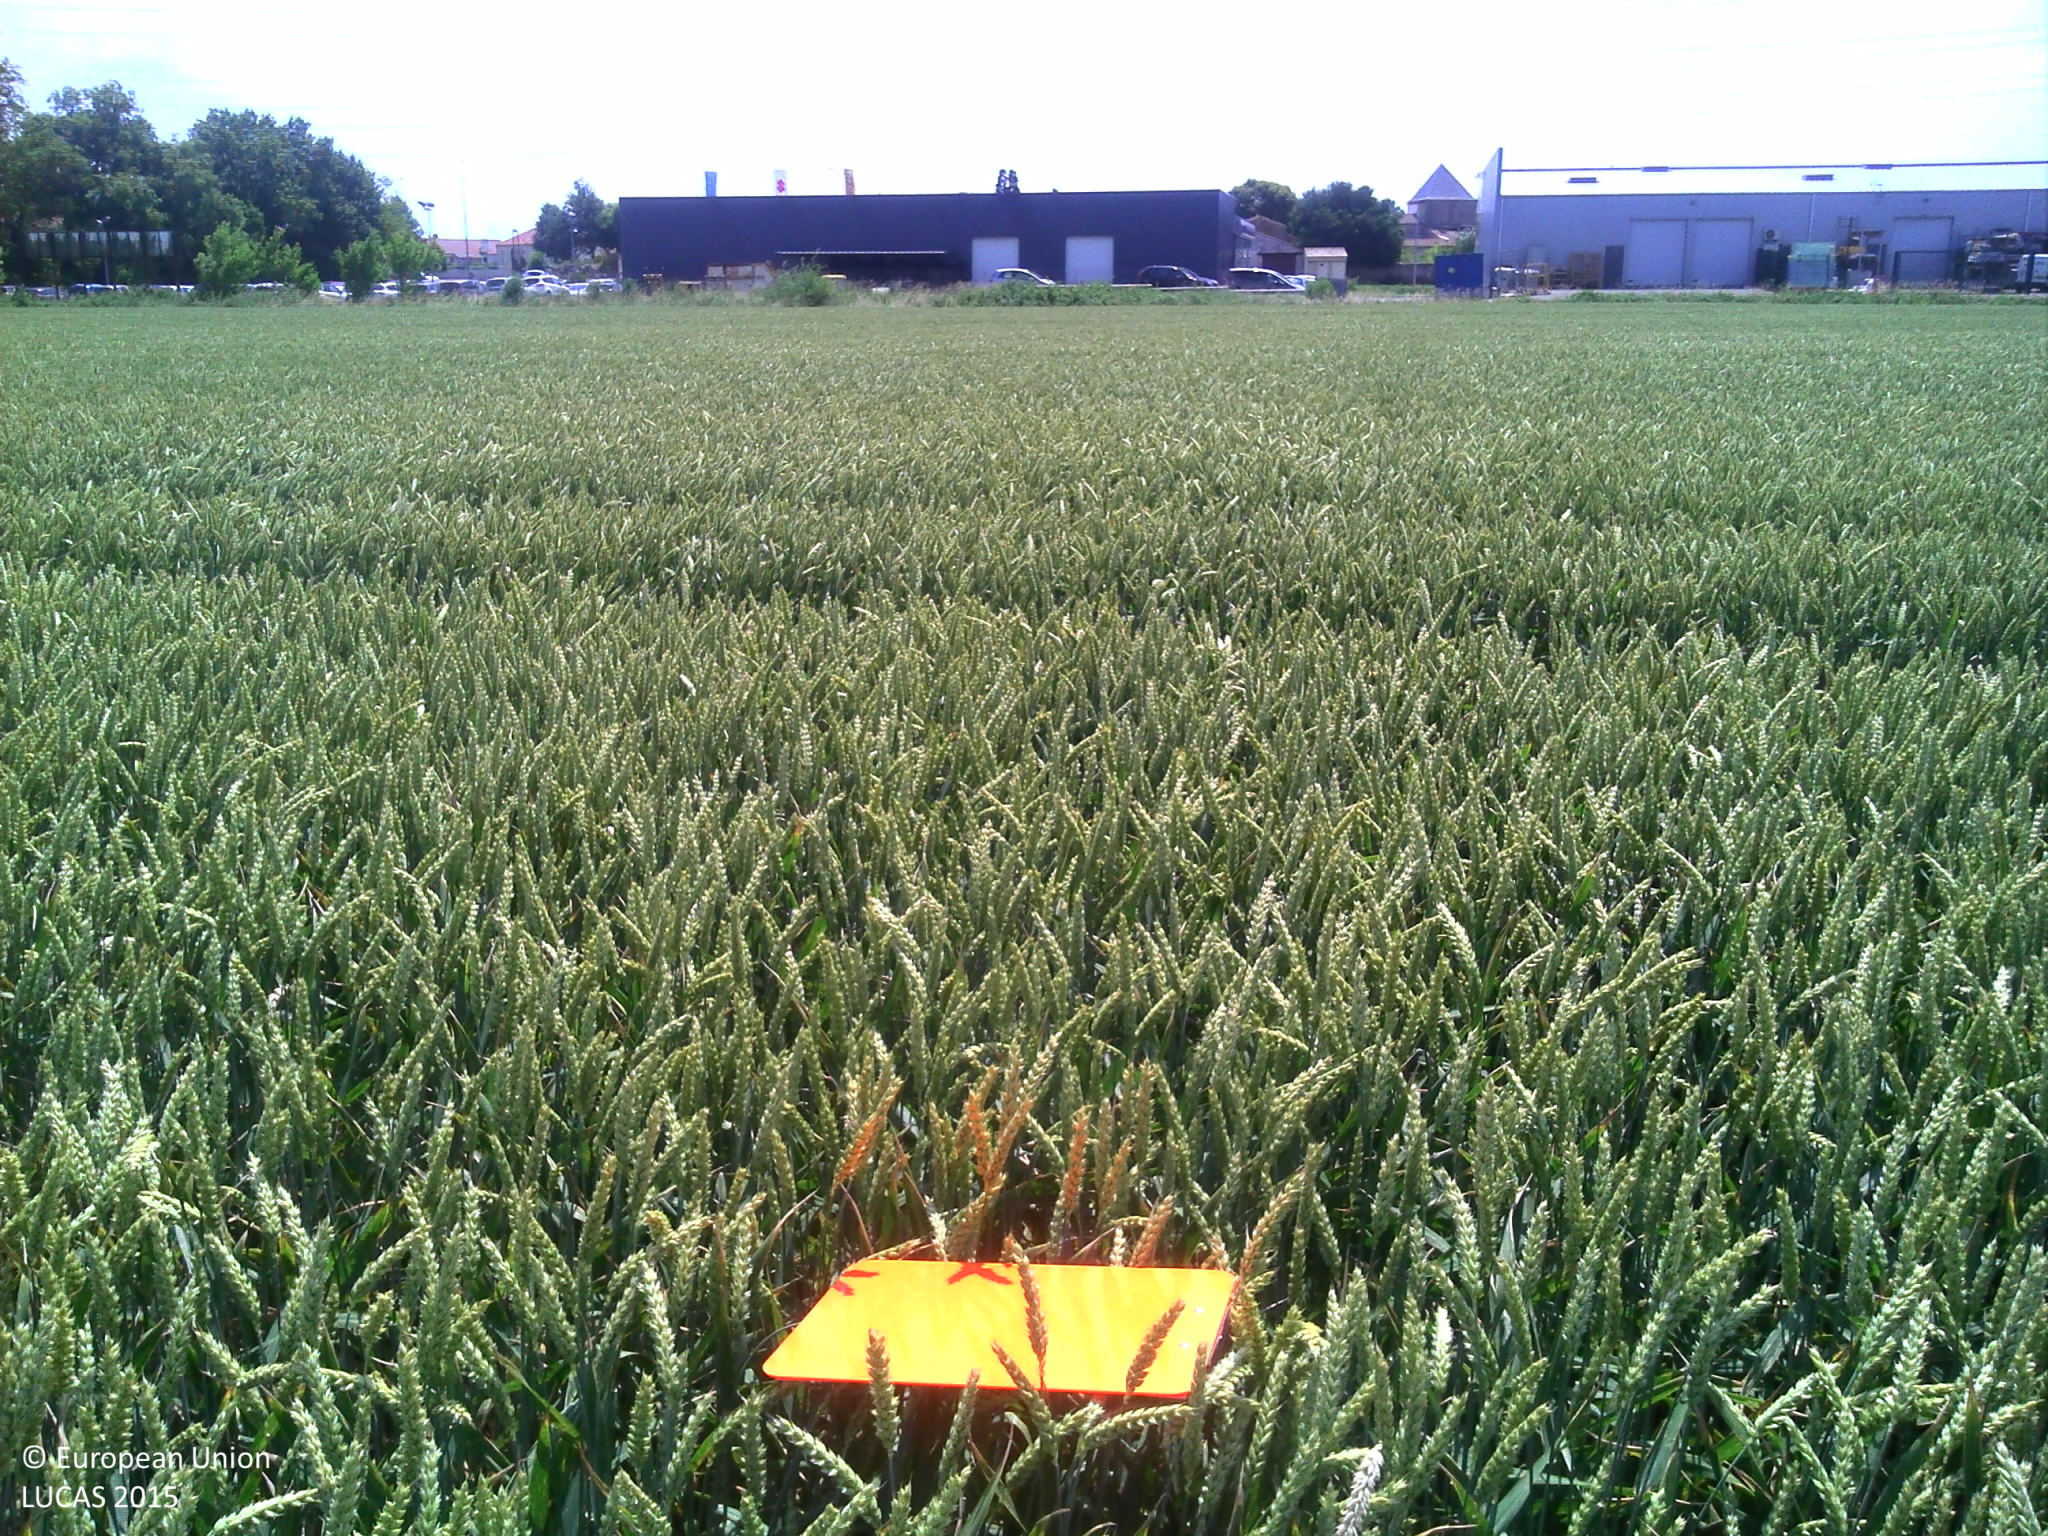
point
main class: Cropland
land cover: Common wheat
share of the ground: > 75 %
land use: Agriculture (excluding fallow land and kitchen gardens)
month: June
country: FR
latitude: 45.9529
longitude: -0.9301
